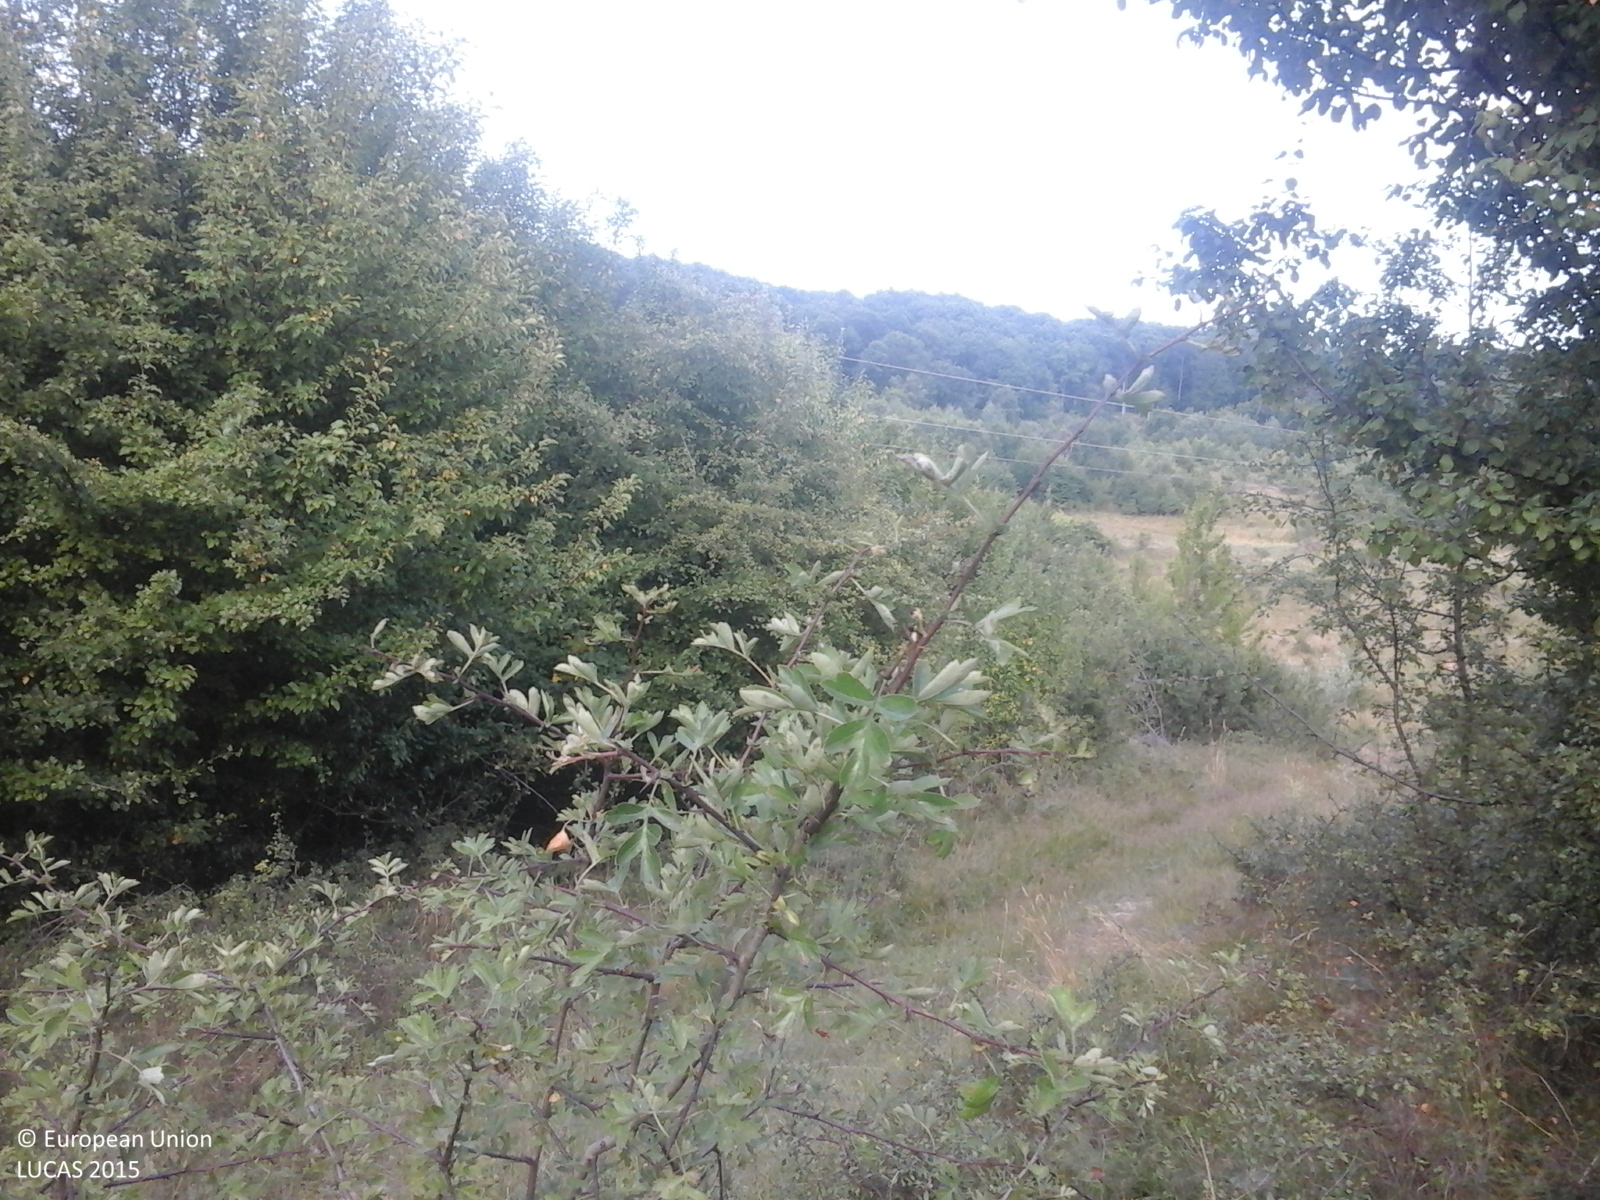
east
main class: Shrubland
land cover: Shrubland with sparse tree cover
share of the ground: > 75 %
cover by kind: shrubs 85 %, herbaceous plants 10 %, broadleaved forest trees 5 %
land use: Semi-natural and natural areas not in use
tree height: < 5 m
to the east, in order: Shrubland with sparse tree cover; Tracks; Broadleaved woodland; Electric lines; Broadleaved woodland; Tracks; Abandoned hedges; Tracks; Broadleaved woodland
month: July
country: RO
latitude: 45.0338
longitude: 24.7154
